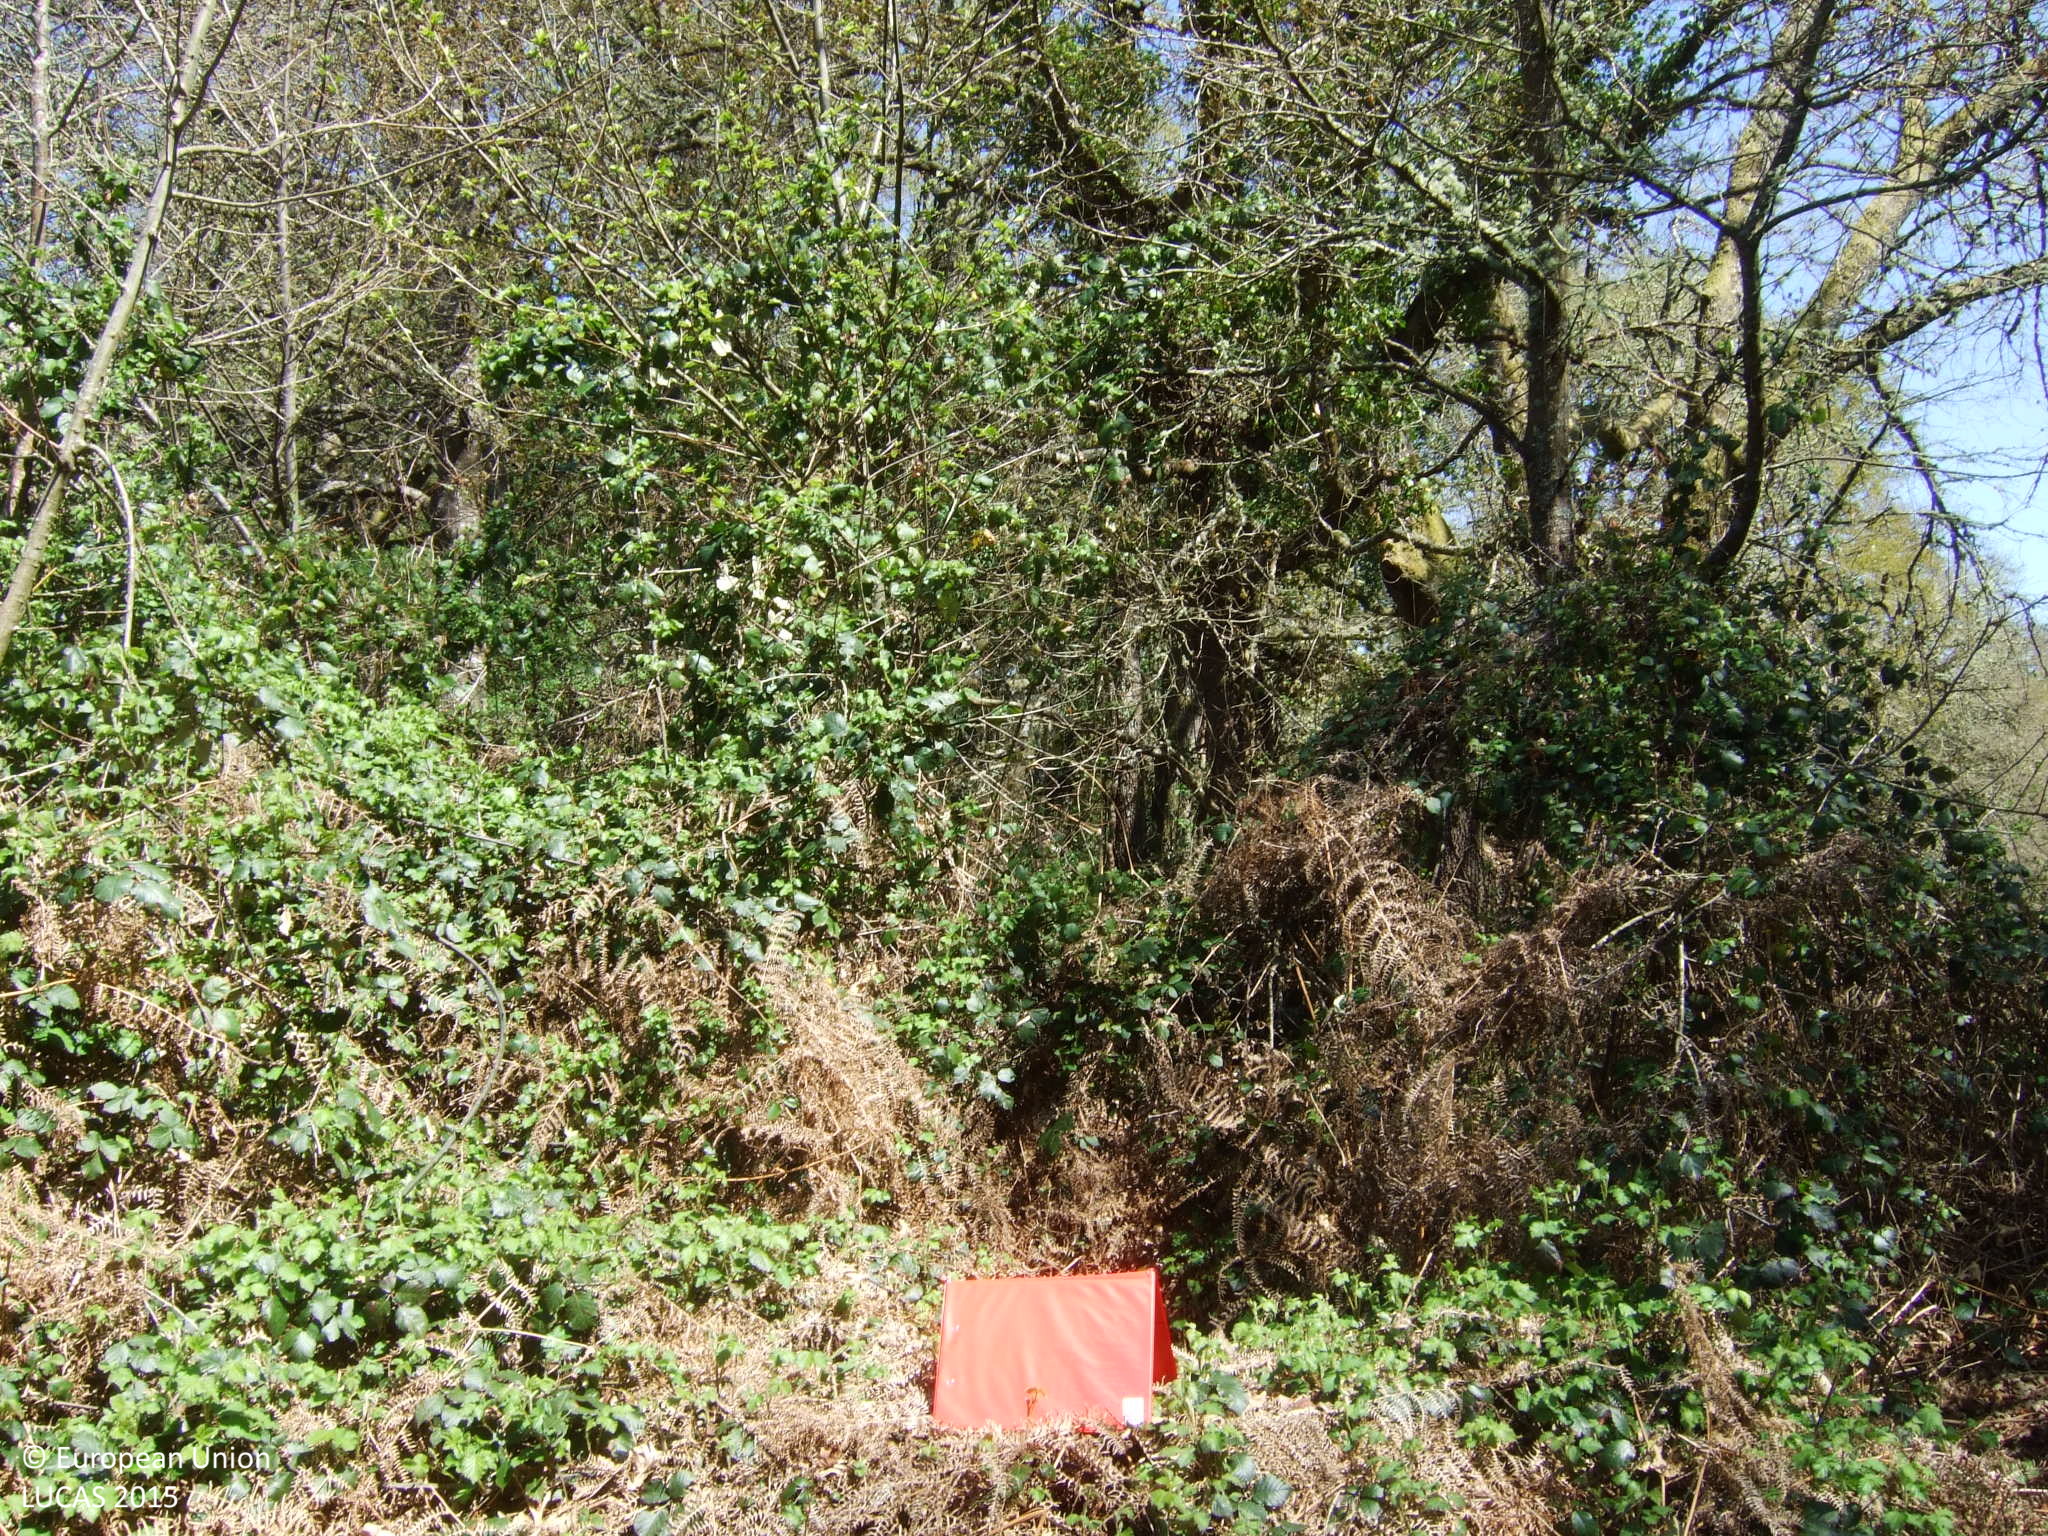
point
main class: Woodland
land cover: Broadleaved woodland
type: acidophilous oak and oak-birch forest
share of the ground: 25 - 50 %
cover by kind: broadleaved forest trees 50 %, shrubs 50 %
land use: Forestry
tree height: > 5 m
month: April
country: ES
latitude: 43.0054
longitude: -7.6598
